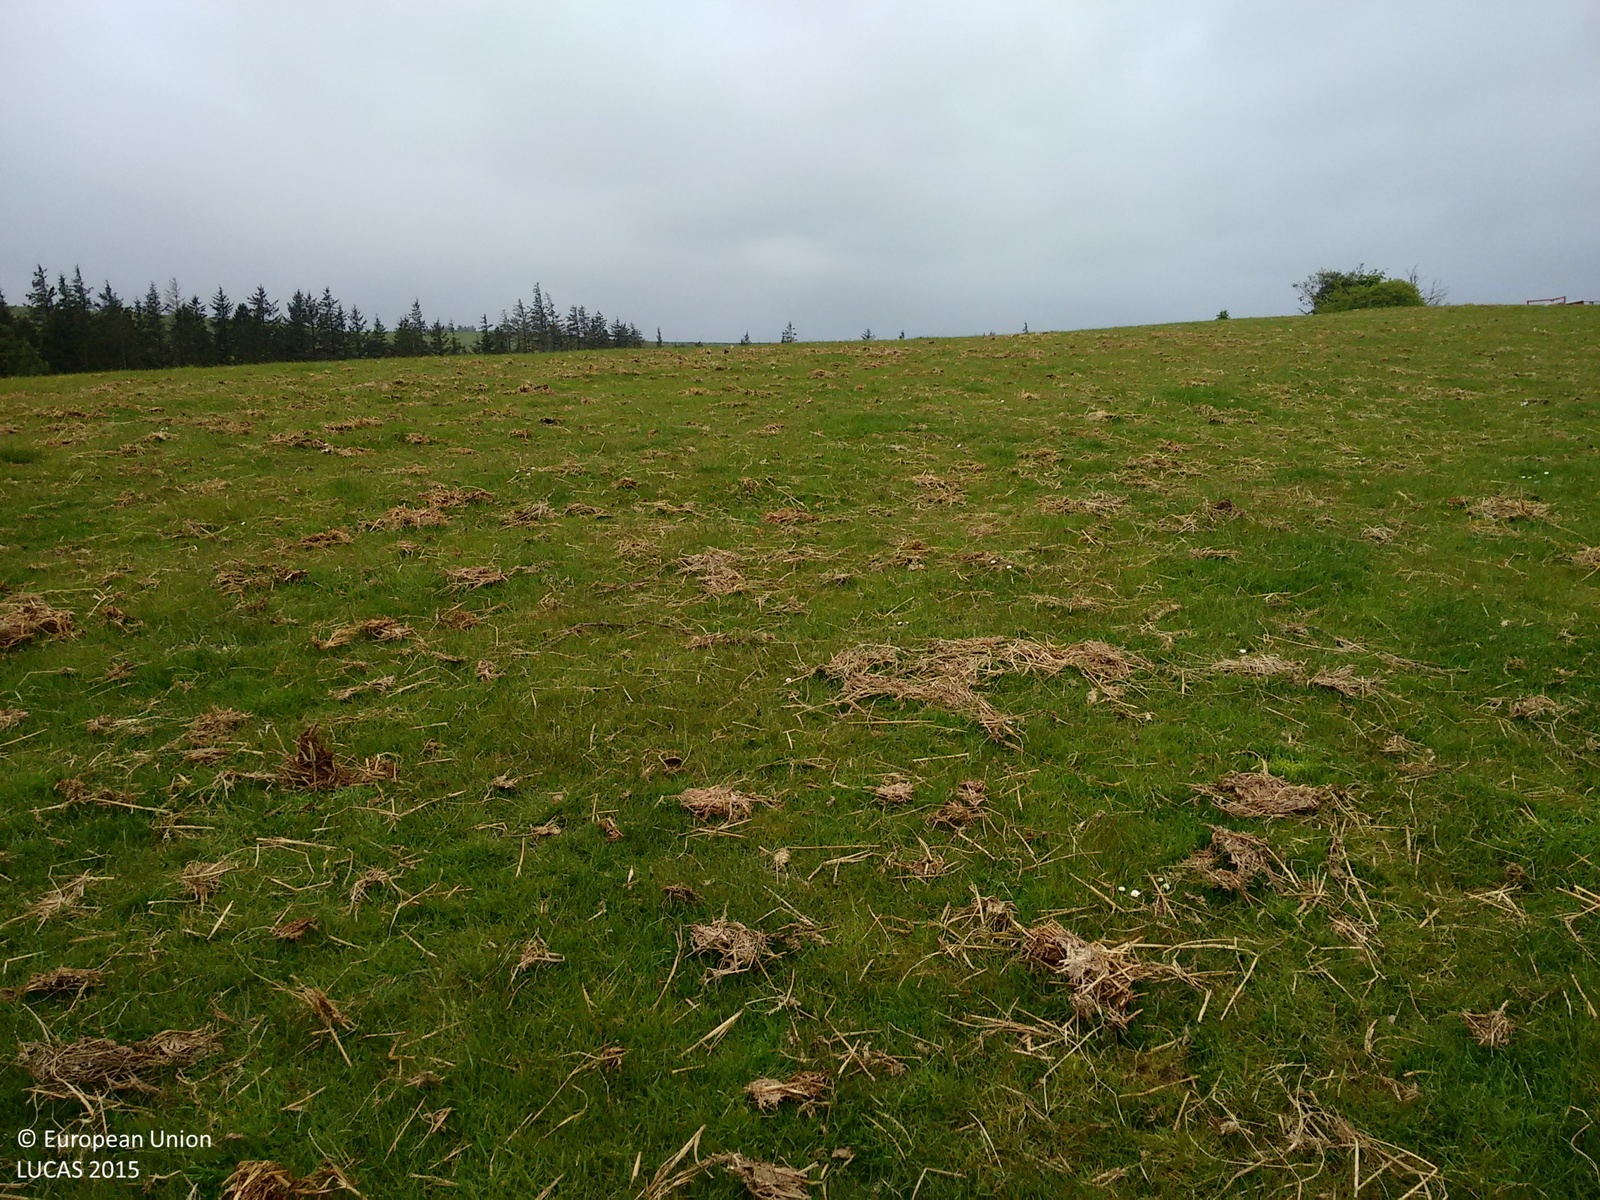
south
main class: Grassland
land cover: Grassland without tree/shrub cover
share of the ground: > 75 %
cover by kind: herbaceous plants 100 %
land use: Agriculture (excluding fallow land and kitchen gardens)
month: June
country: GB
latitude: 55.0871
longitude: -2.2630
